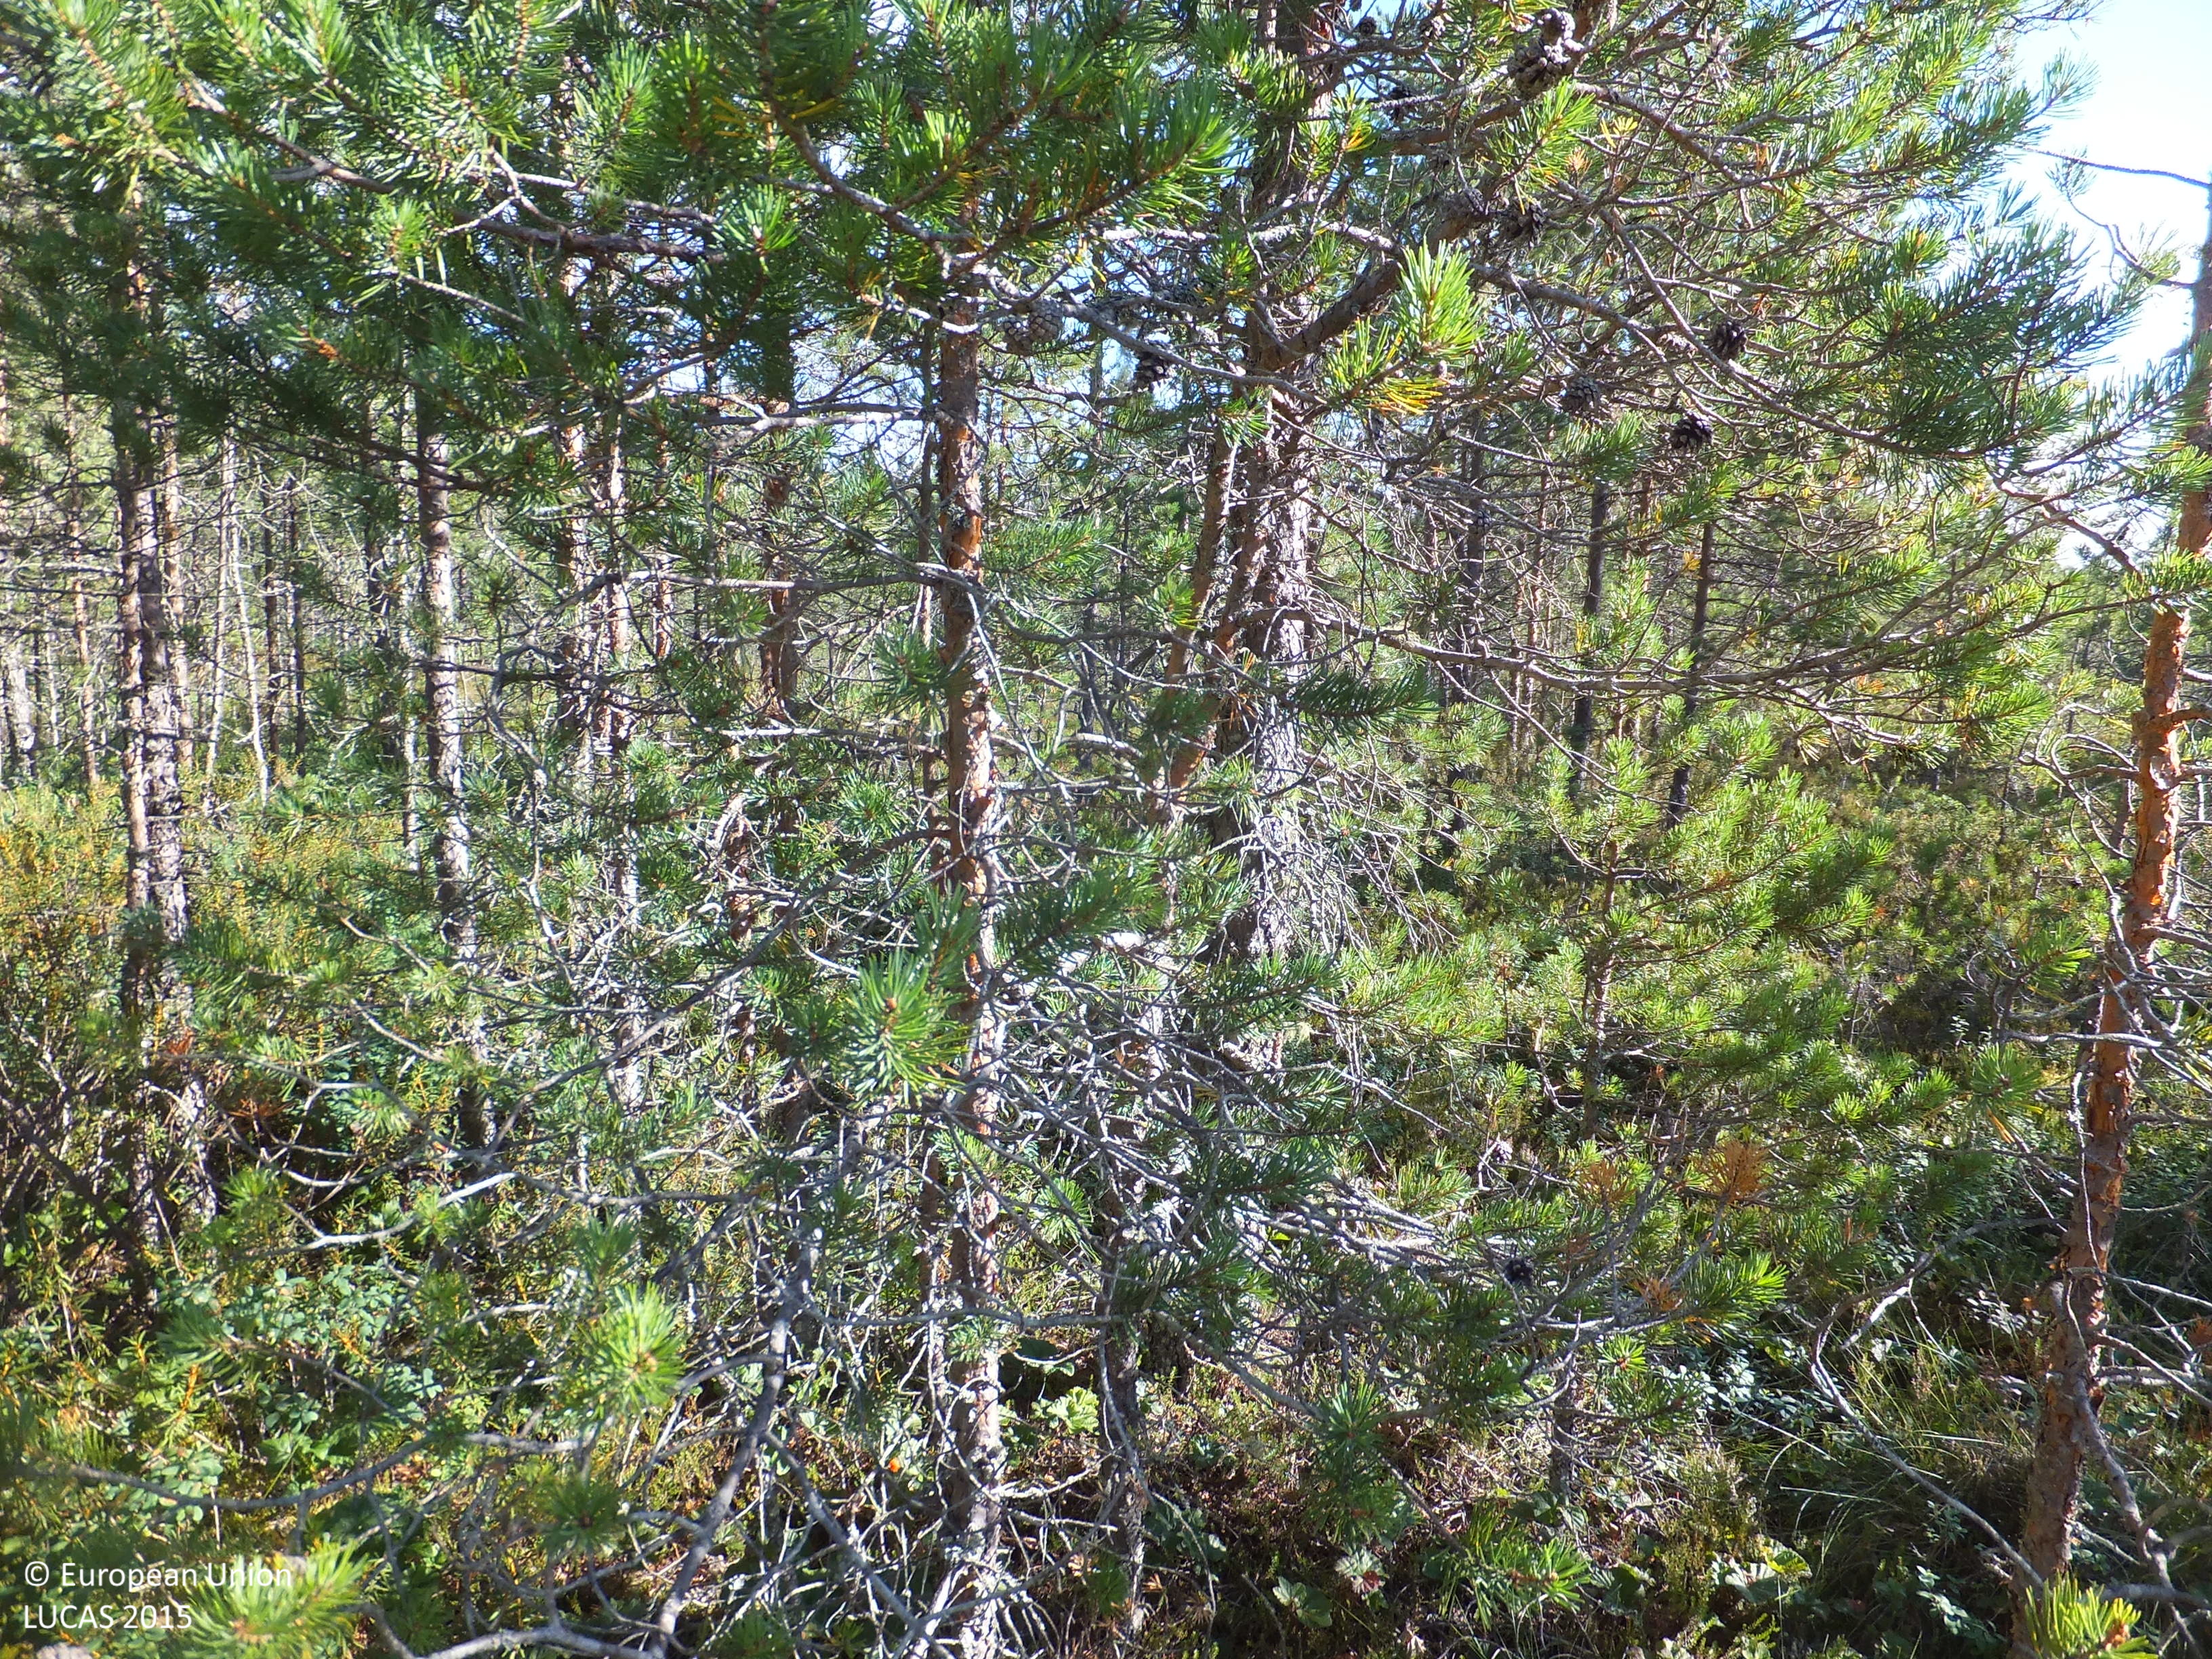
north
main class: Woodland
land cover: Pine dominated coniferous woodland
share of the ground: 50 - 75 %
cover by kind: coniferous forest trees 50 %, shrubs 30 %, lichens and mosses 15 %, herbaceous plants 5 %
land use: Forestry
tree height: < 5 m
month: August
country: FI
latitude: 63.1044
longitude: 22.8357
